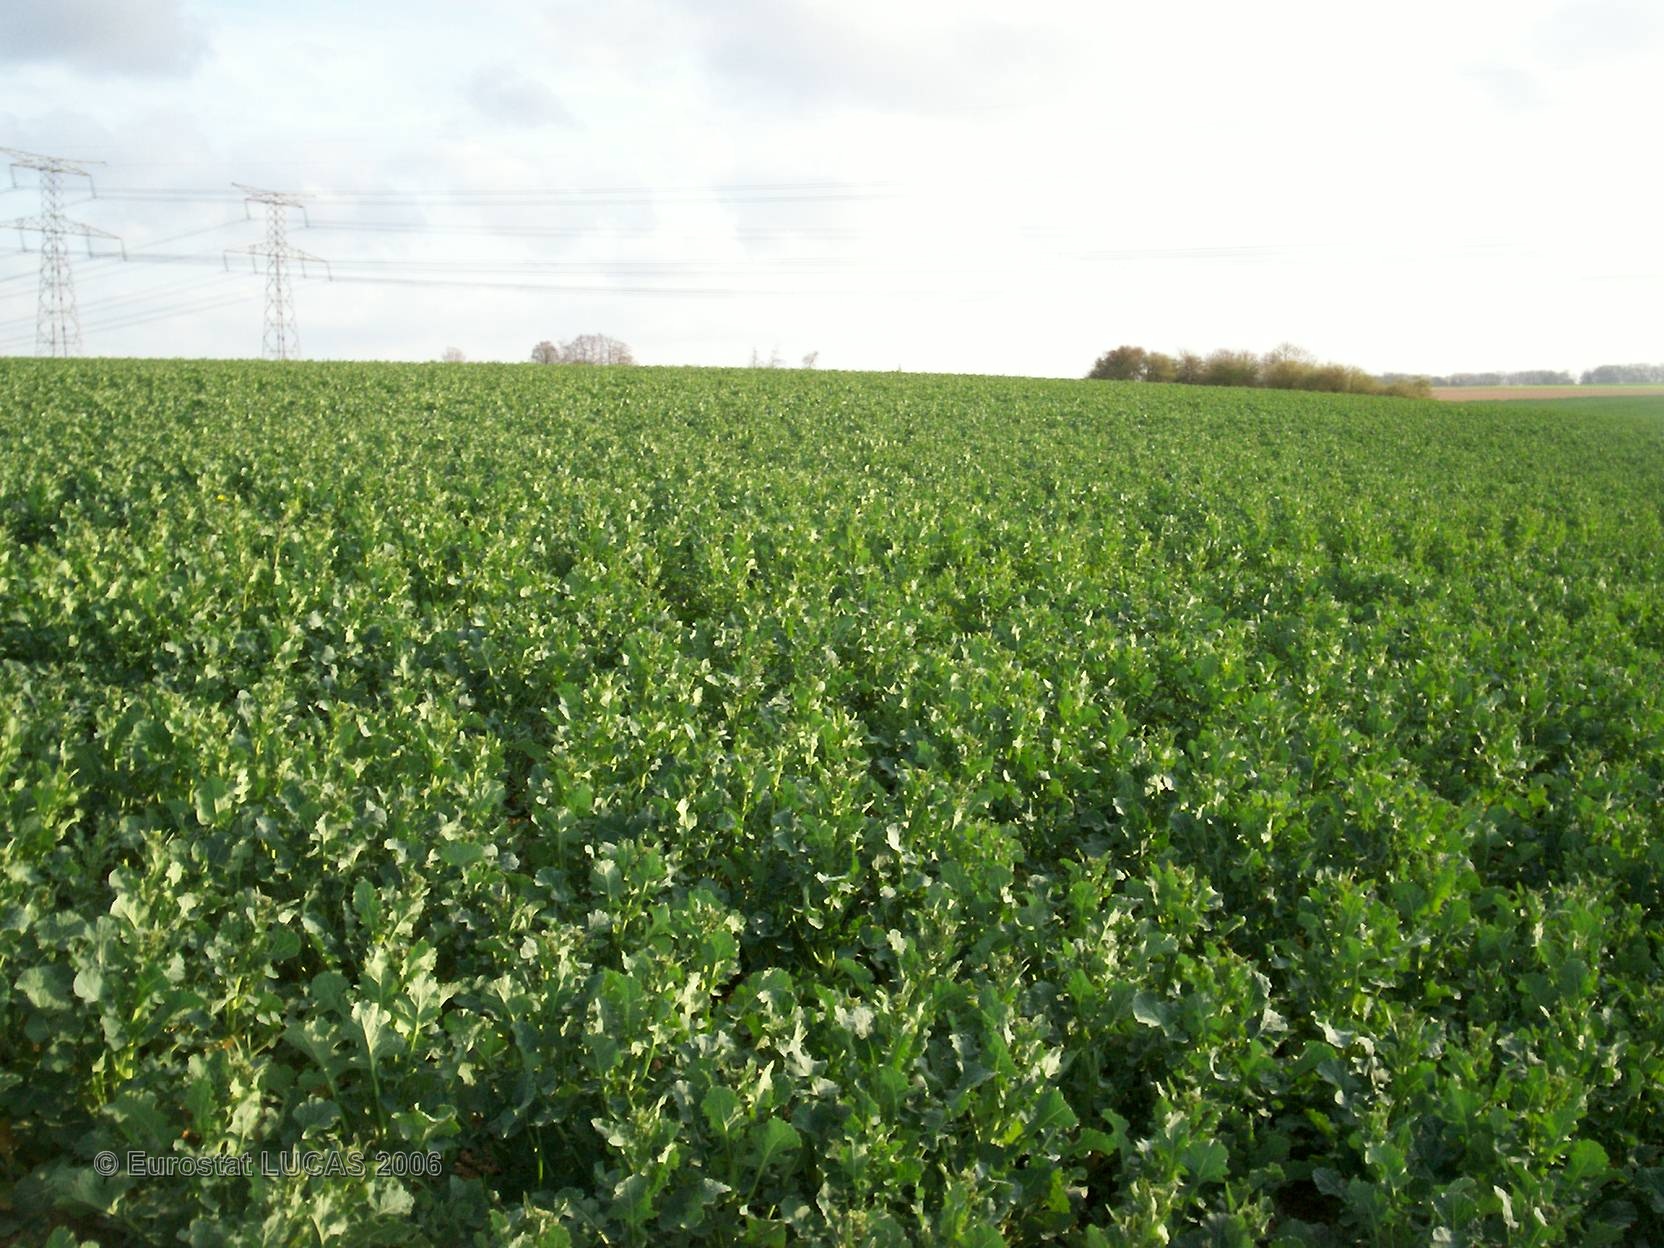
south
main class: Cropland
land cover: Rape and turnip rape
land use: Agriculture (excluding fallow land and kitchen gardens)
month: April
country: FR
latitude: 49.6949
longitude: 0.9241
